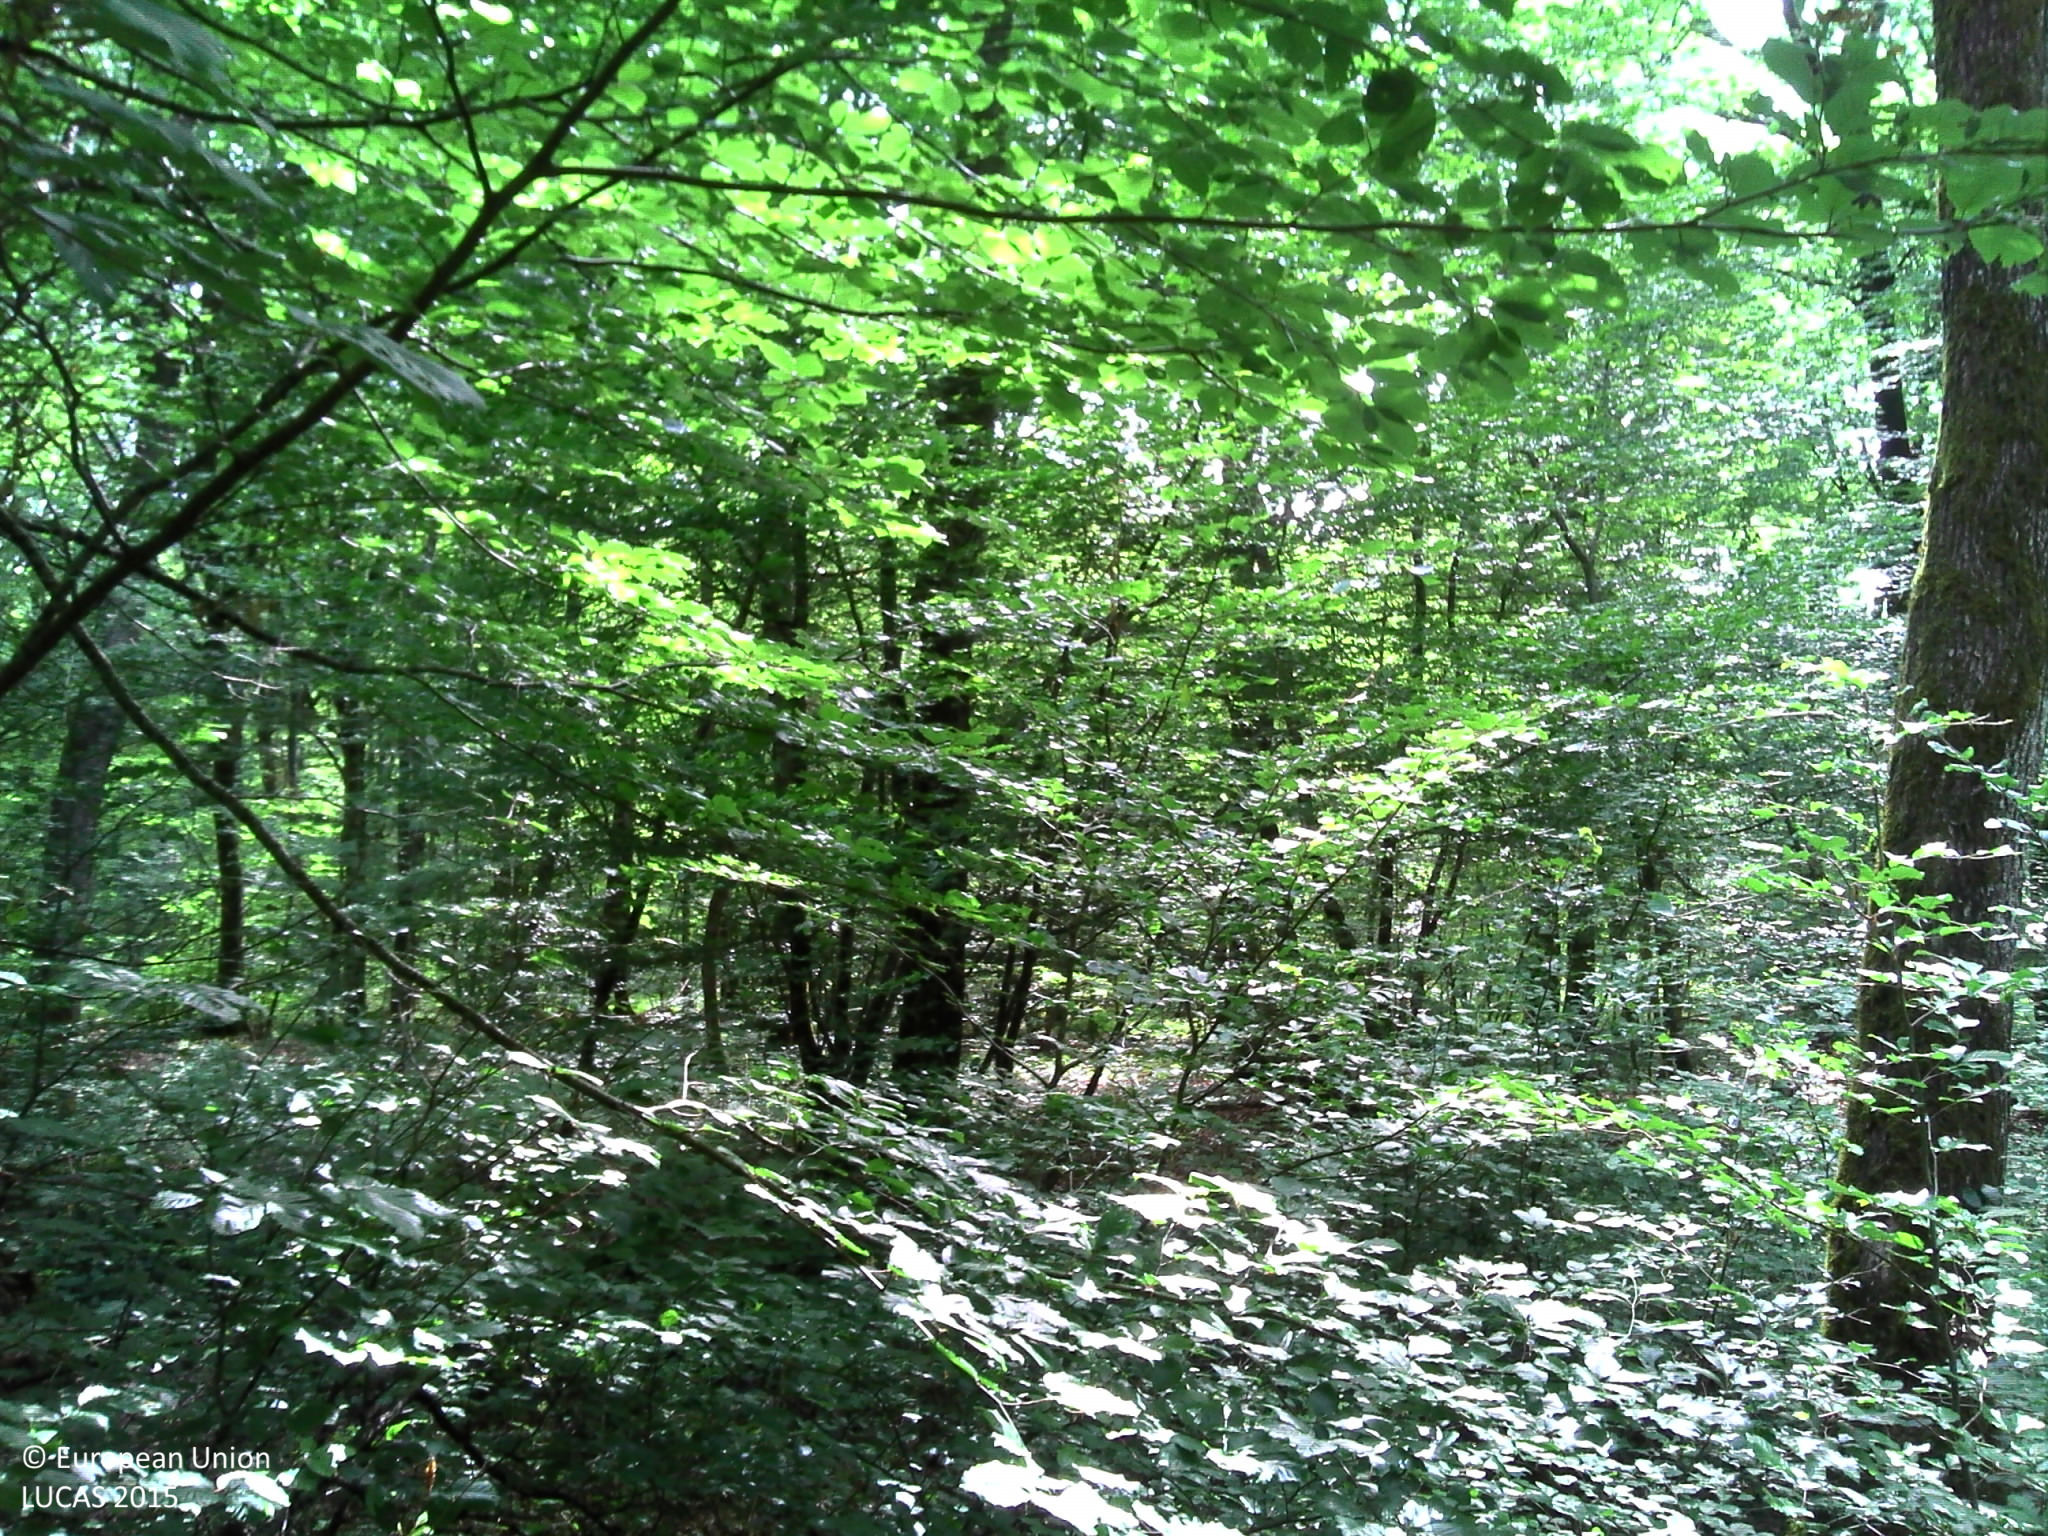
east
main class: Woodland
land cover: Broadleaved woodland
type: mesophytic deciduous forest
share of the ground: > 75 %
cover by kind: broadleaved forest trees 85 %, shrubs 10 %, herbaceous plants 5 %
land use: Forestry
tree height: > 5 m
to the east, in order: Broadleaved woodland
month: June
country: FR
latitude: 47.1256
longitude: 3.1544
